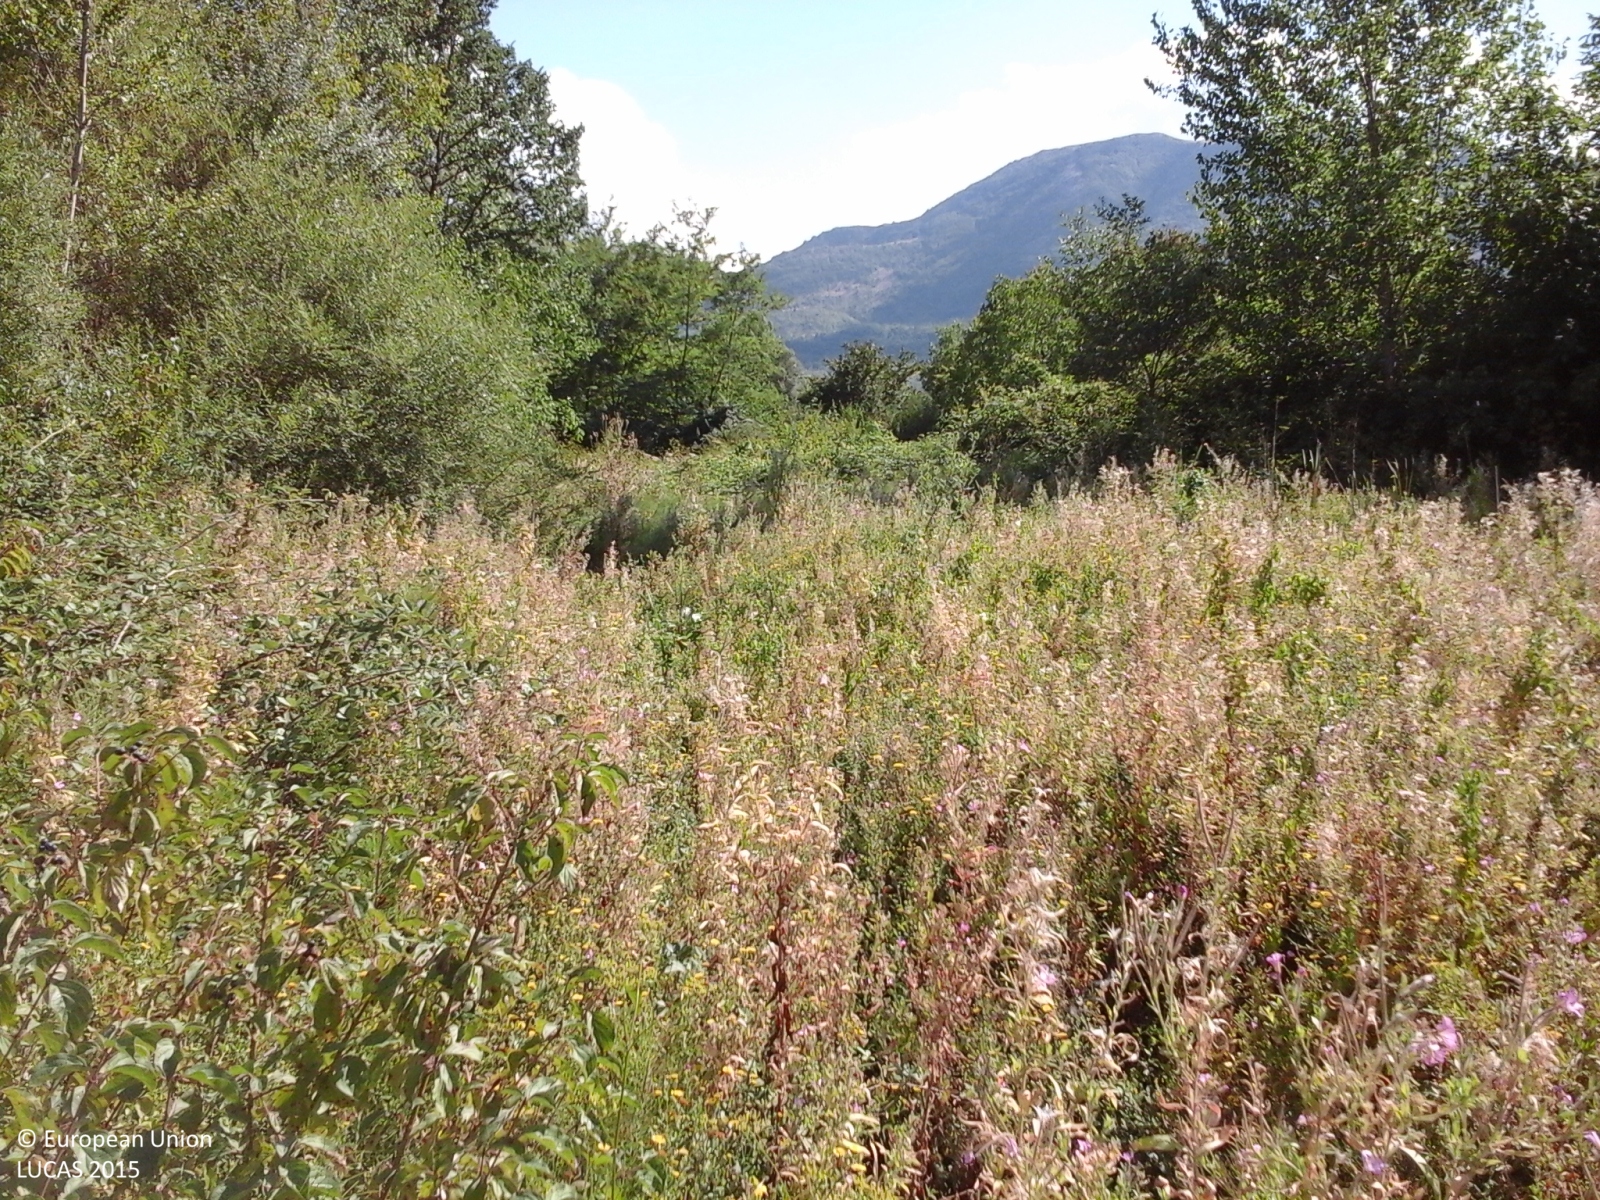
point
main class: Grassland
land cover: Spontaneously vegetated surfaces
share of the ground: > 75 %
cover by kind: herbaceous plants 100 %
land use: Fallow land
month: August
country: IT
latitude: 41.5470
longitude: 14.3600
